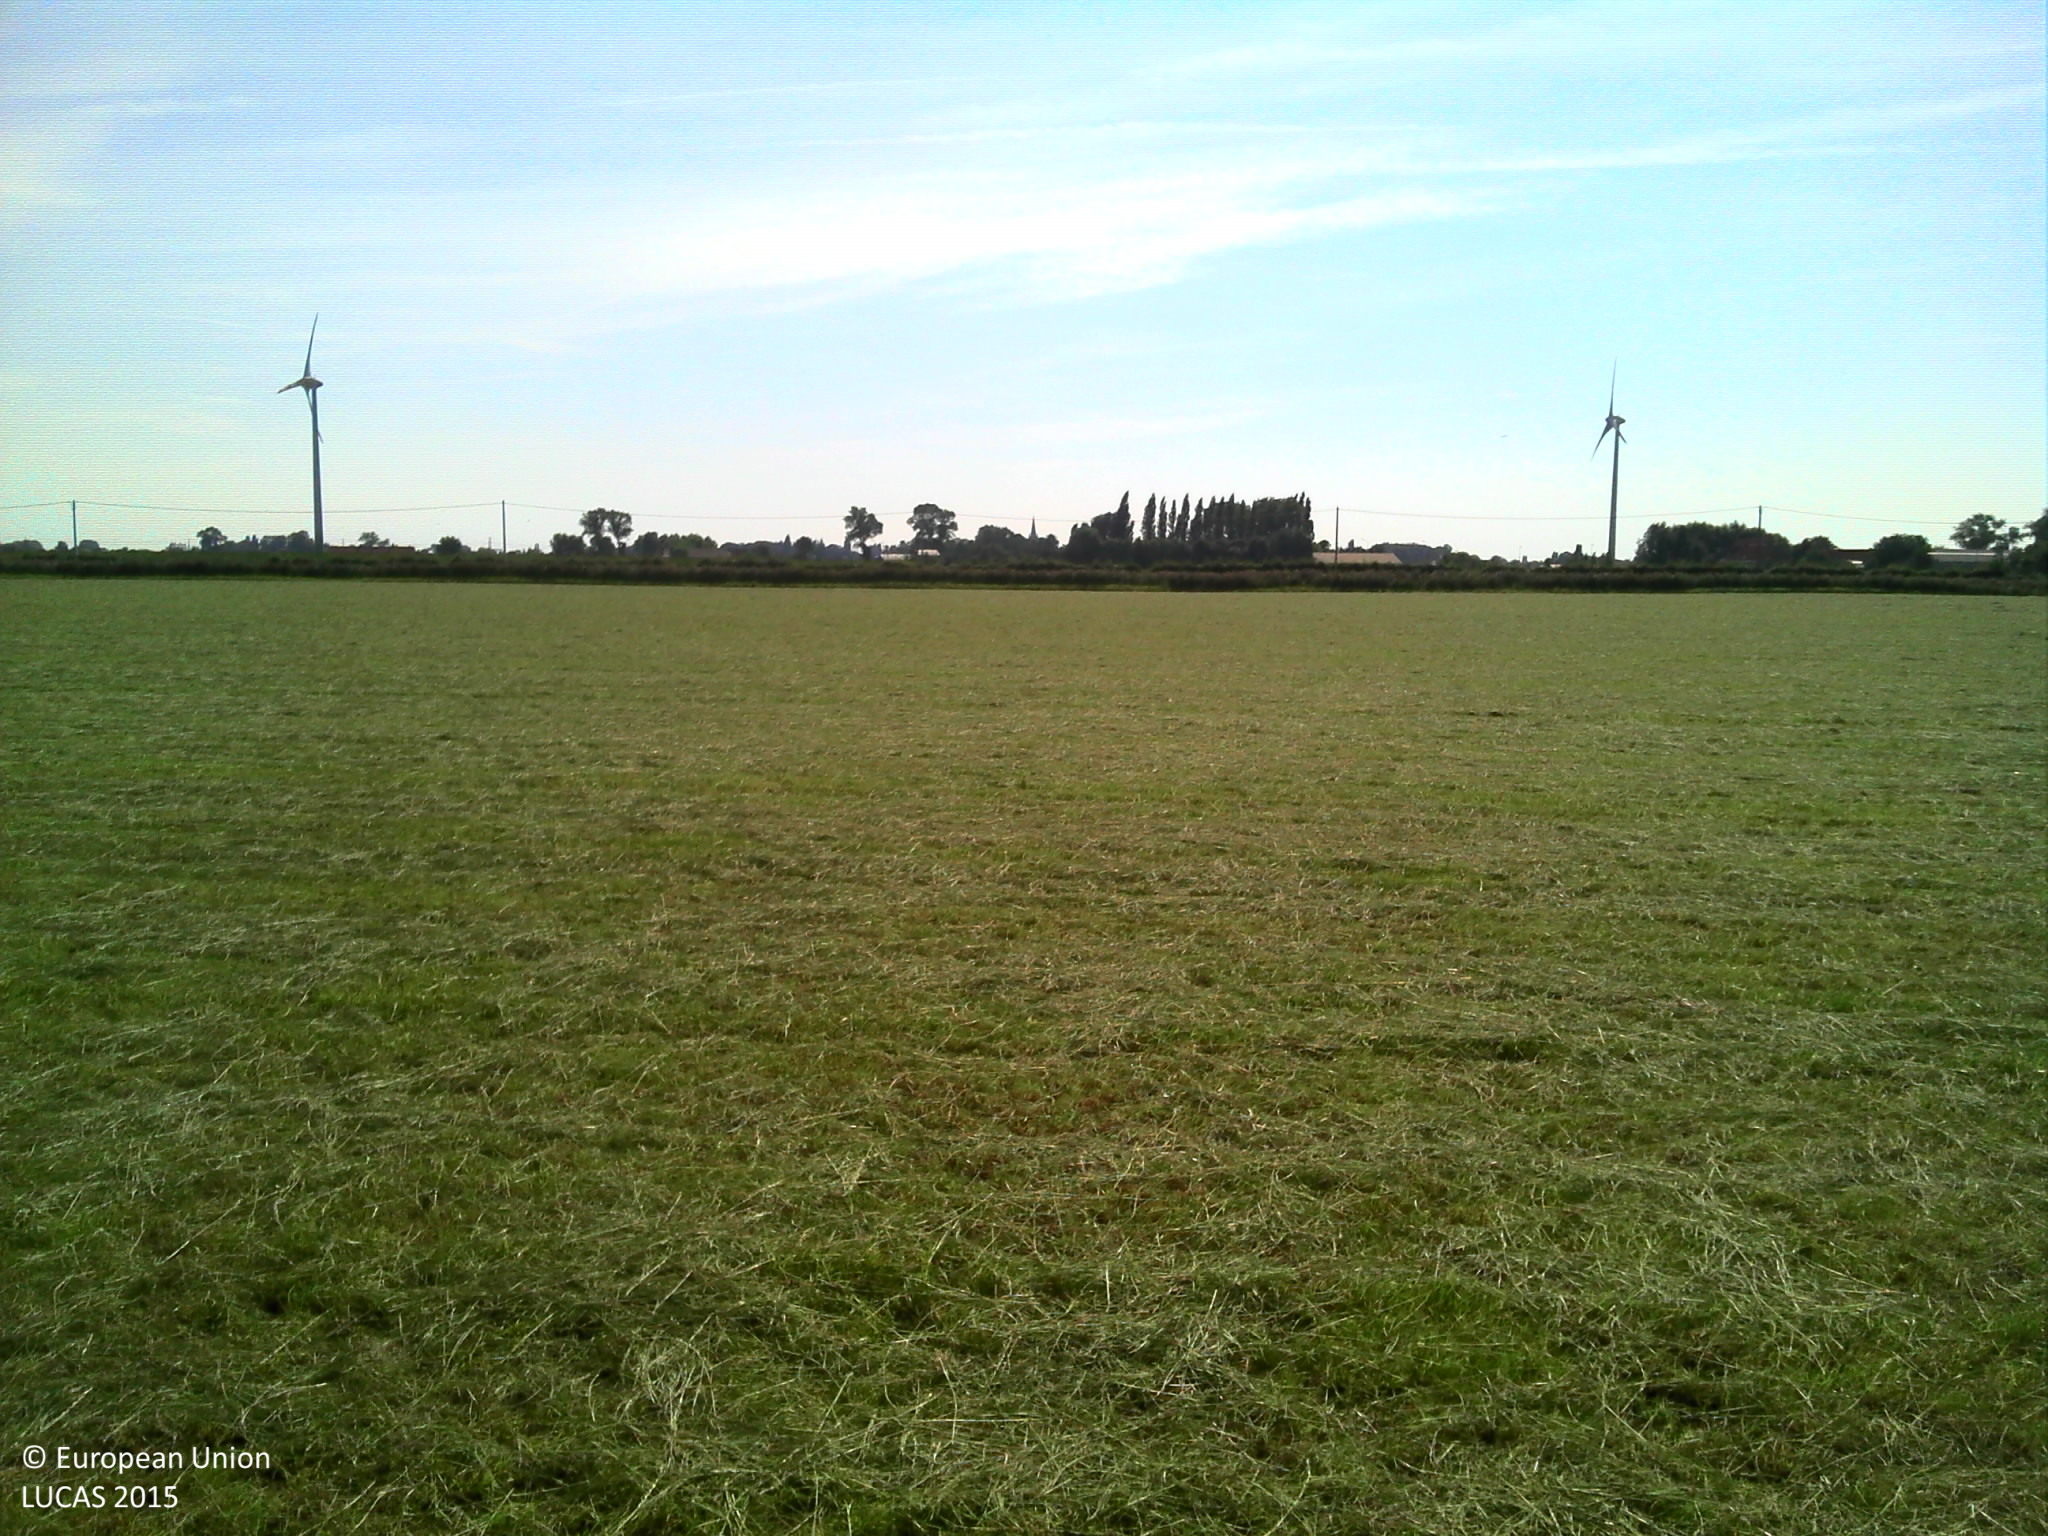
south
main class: Grassland
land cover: Grassland without tree/shrub cover
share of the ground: > 75 %
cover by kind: herbaceous plants 100 %
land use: Agriculture (excluding fallow land and kitchen gardens)
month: September
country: BE
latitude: 51.1762
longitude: 2.9664
